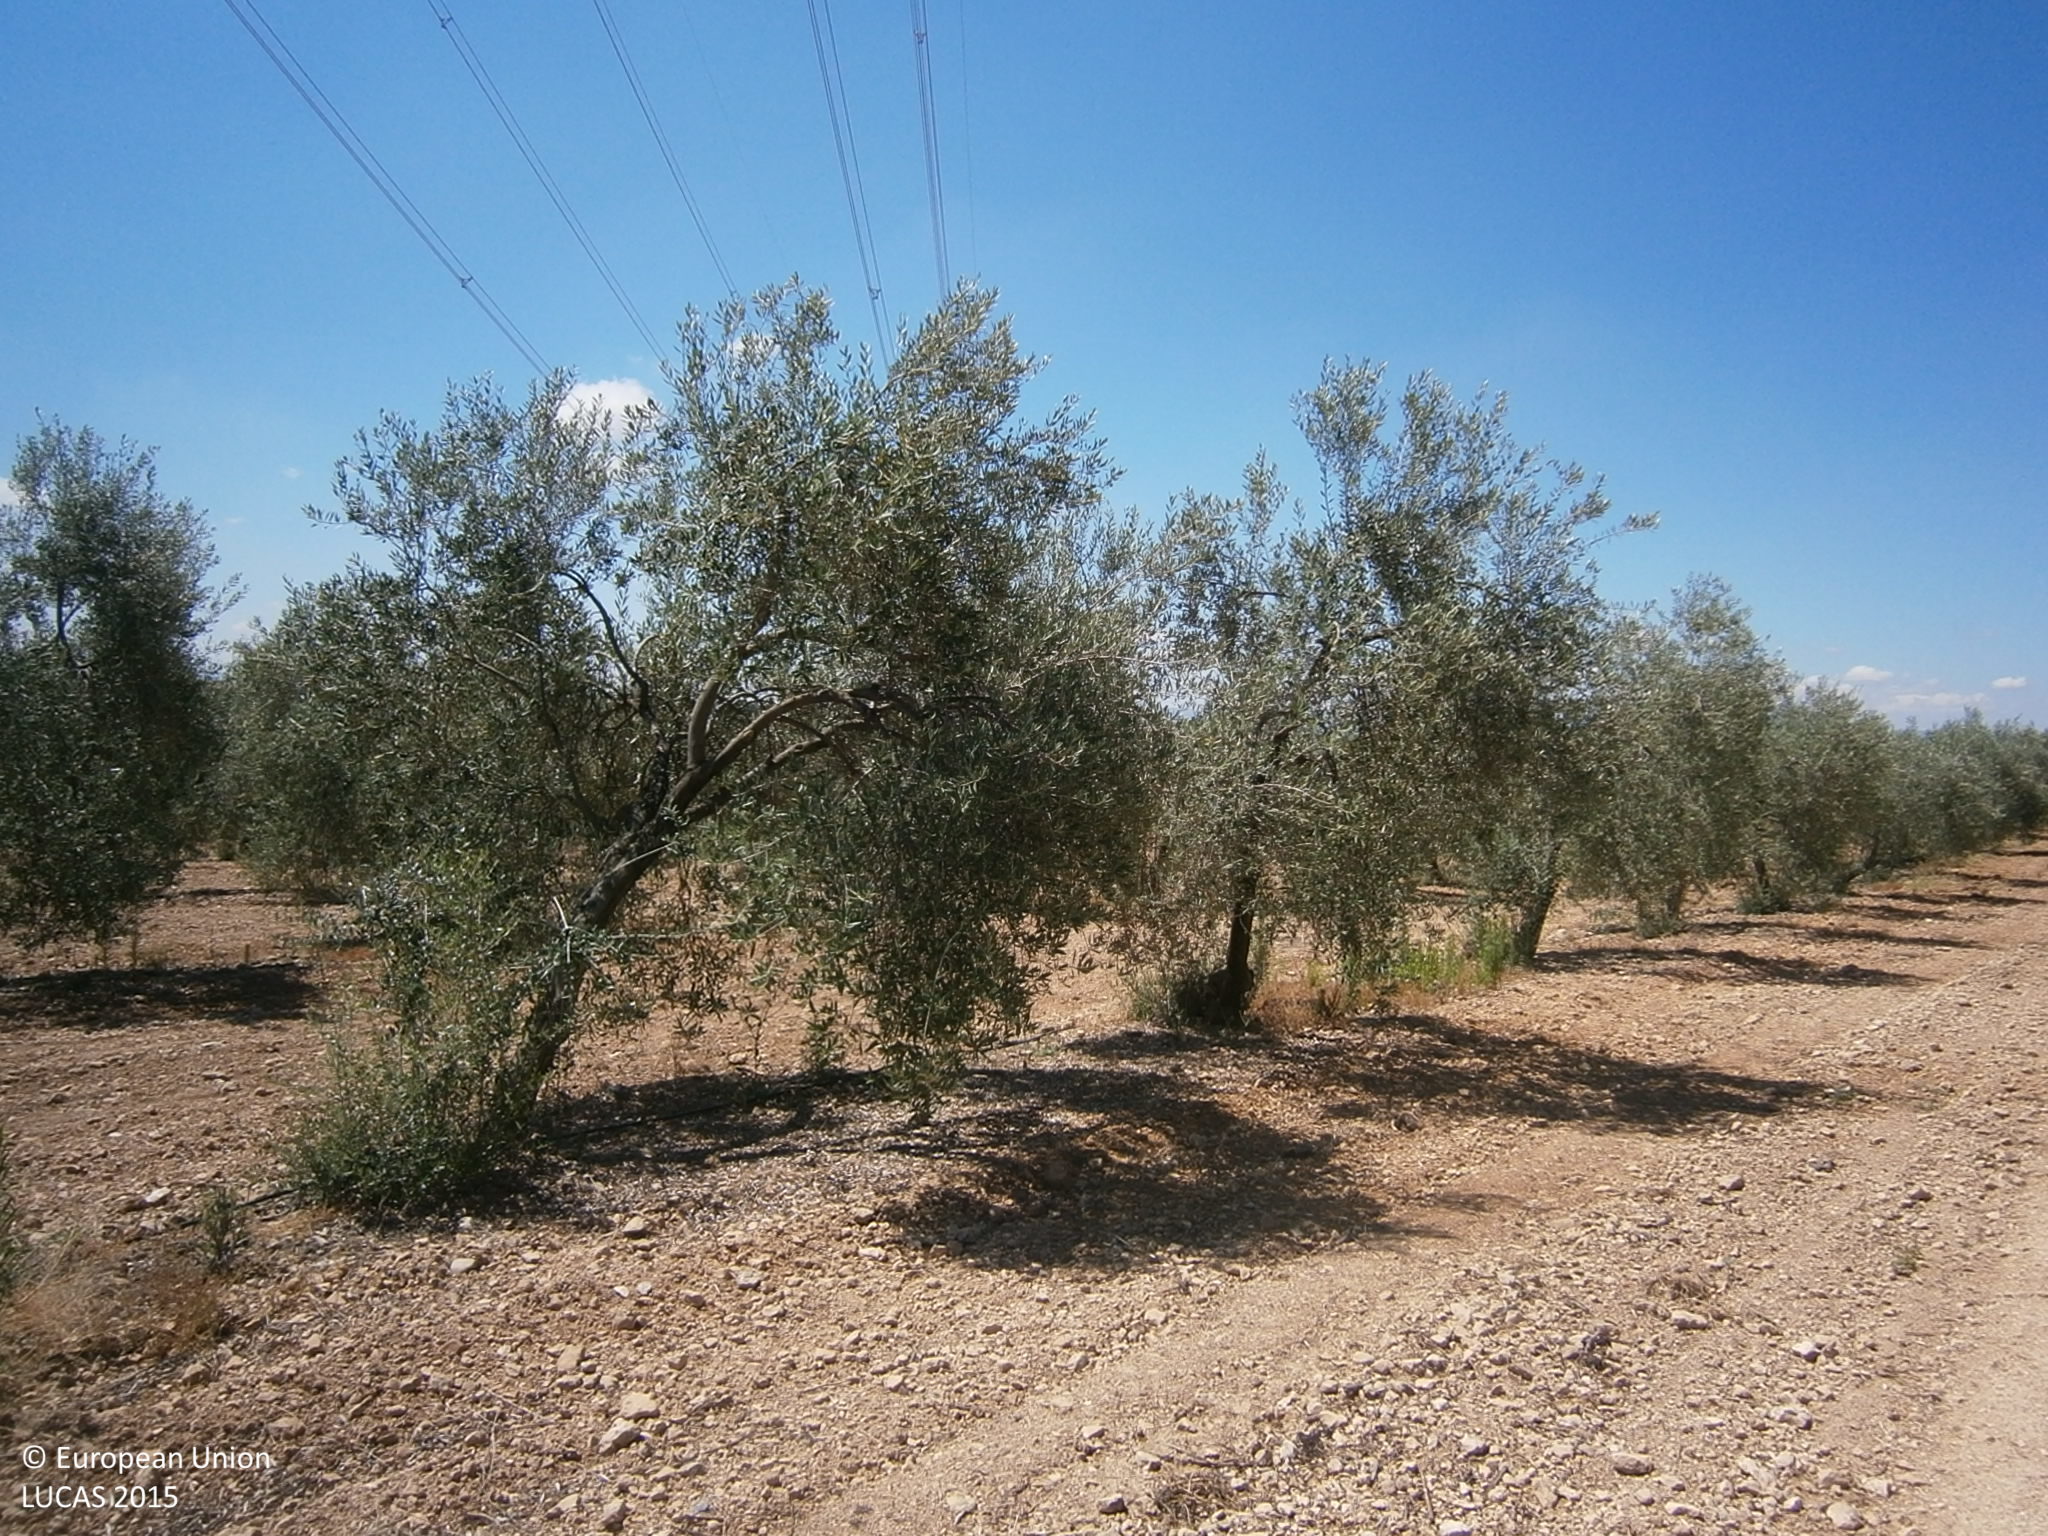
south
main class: Cropland
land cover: Olive groves
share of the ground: 25 - 50 %
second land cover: Other bare soil
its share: > 75 %
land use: Agriculture (excluding fallow land and kitchen gardens)
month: June
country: ES
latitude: 38.7488
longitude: -6.5000
